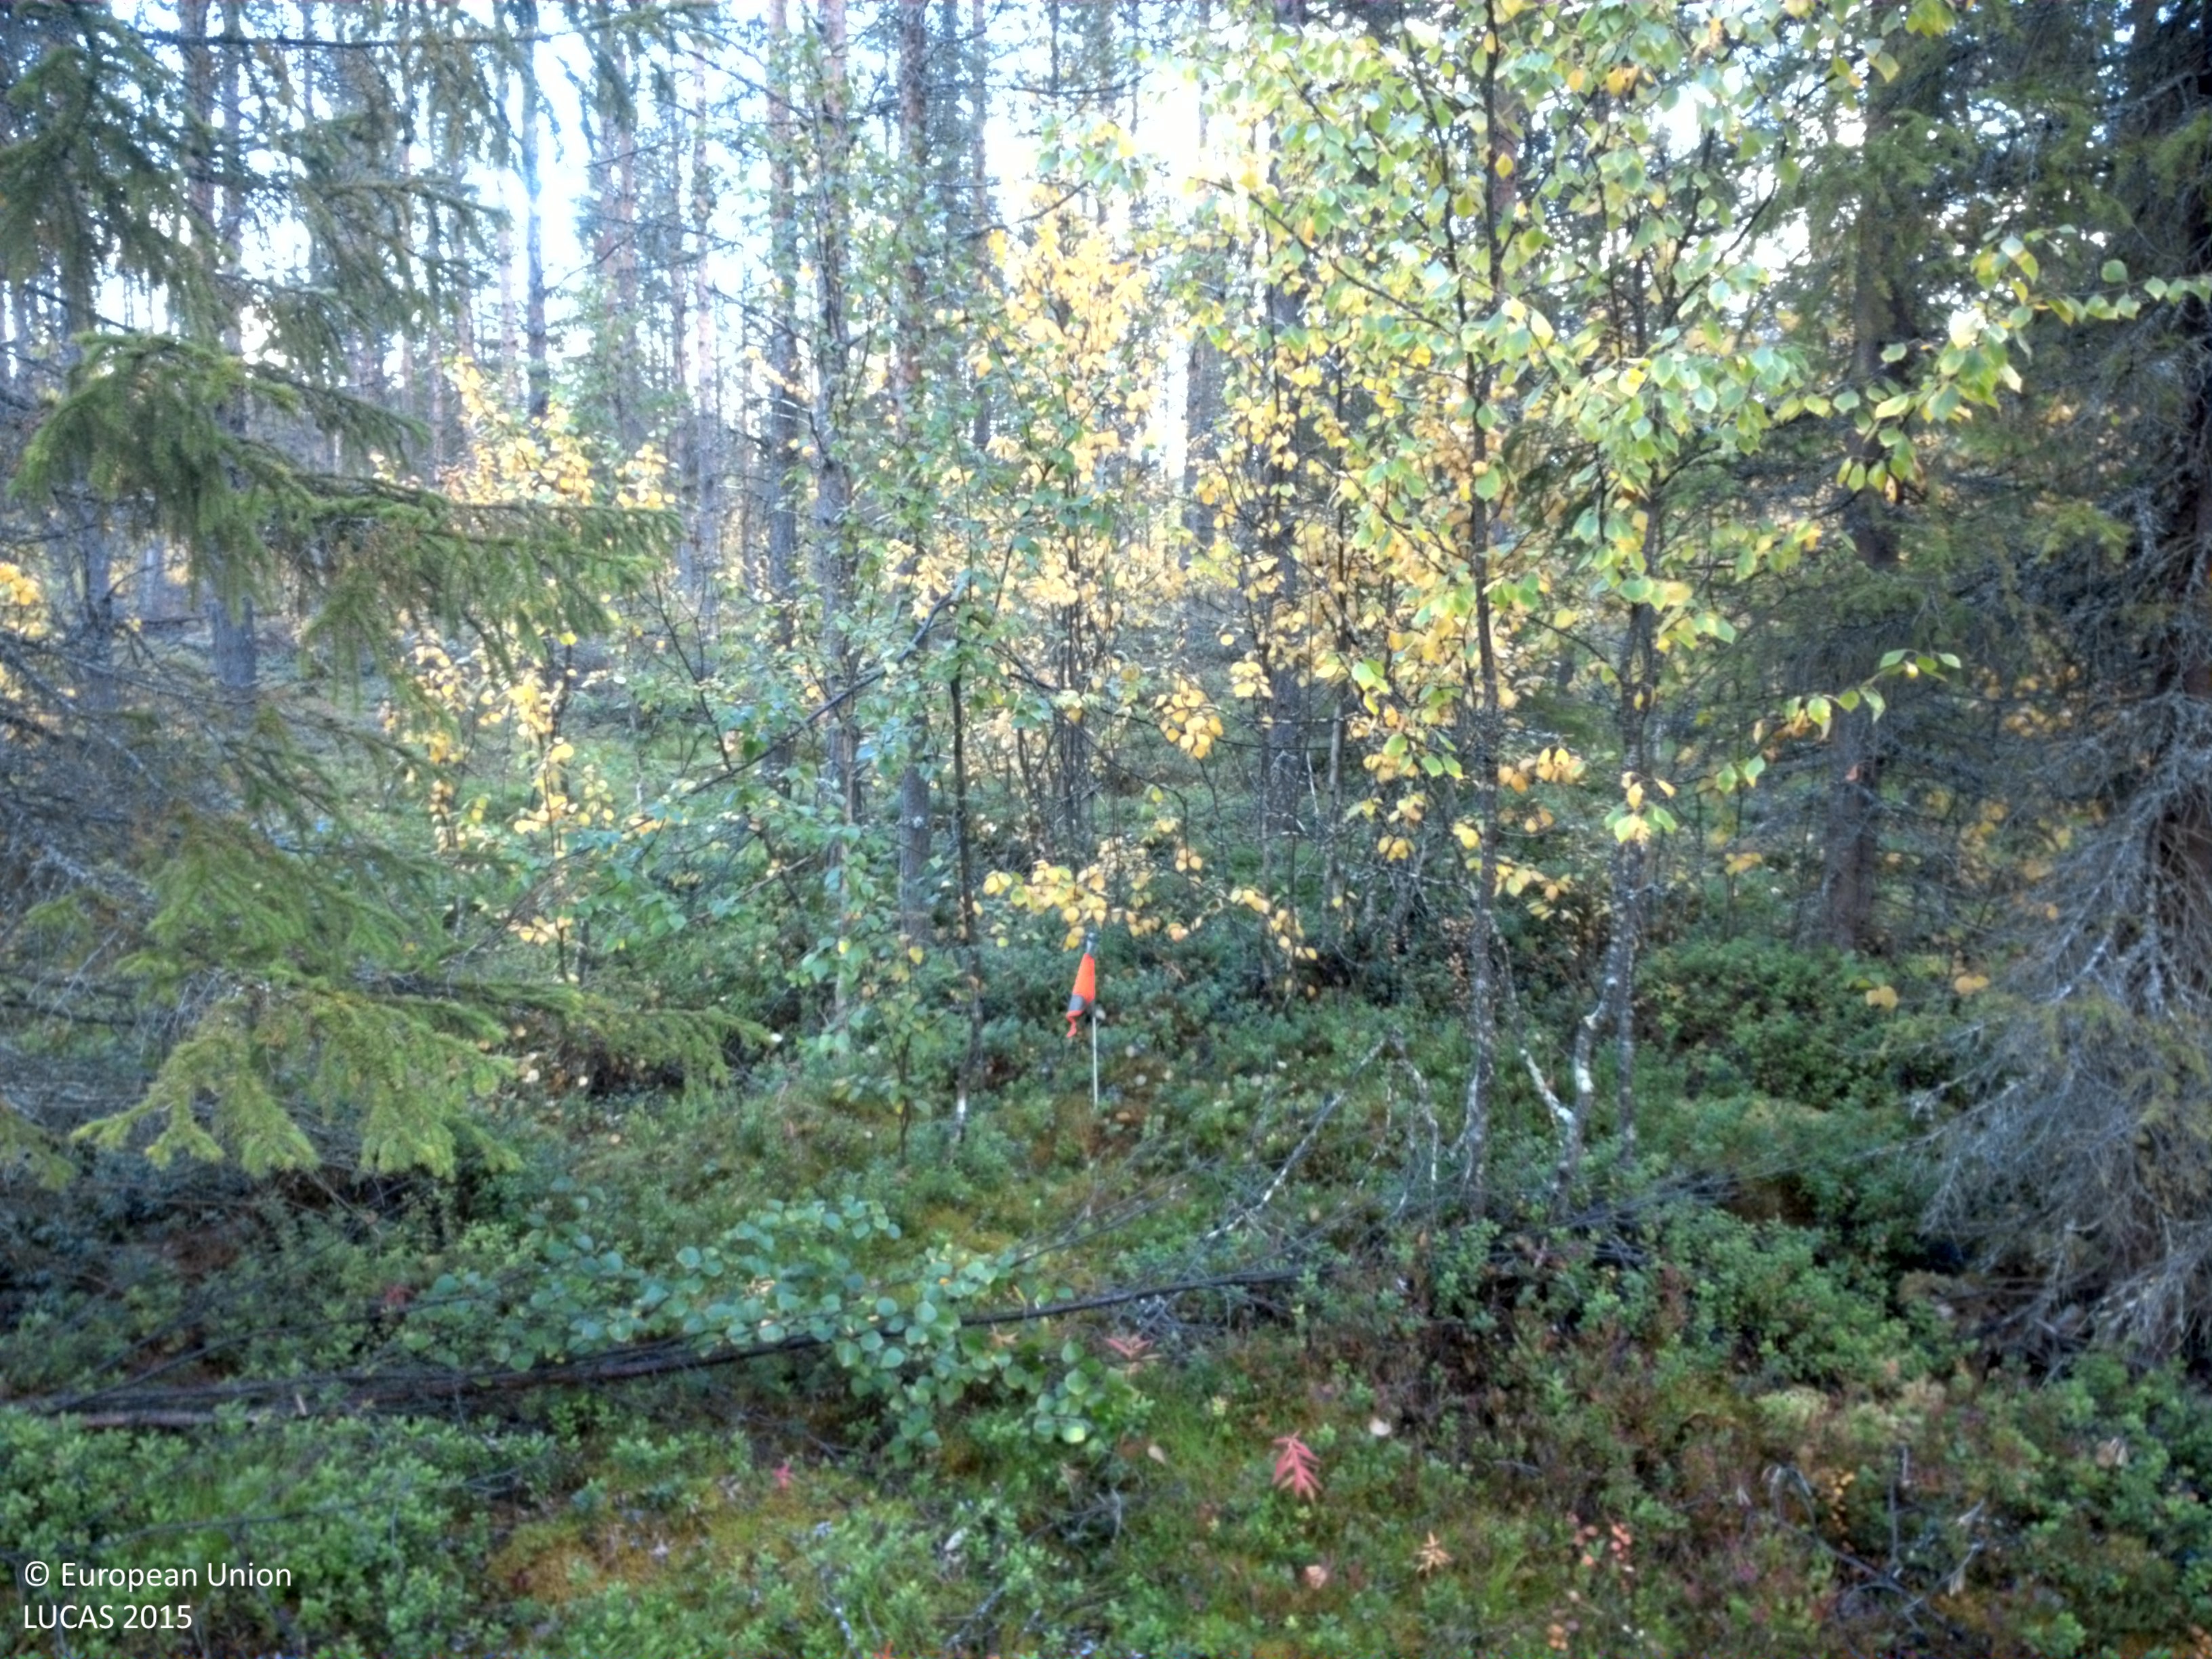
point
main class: Woodland
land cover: Pine dominated mixed woodland
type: boreal forest
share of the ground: 25 - 50 %
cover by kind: shrubs 35 %, coniferous forest trees 25 %, lichens and mosses 15 %, broadleaved forest trees 10 %, herbaceous plants 10 %
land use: Forestry
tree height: > 5 m
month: September
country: SE
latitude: 65.2232
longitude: 16.5711
